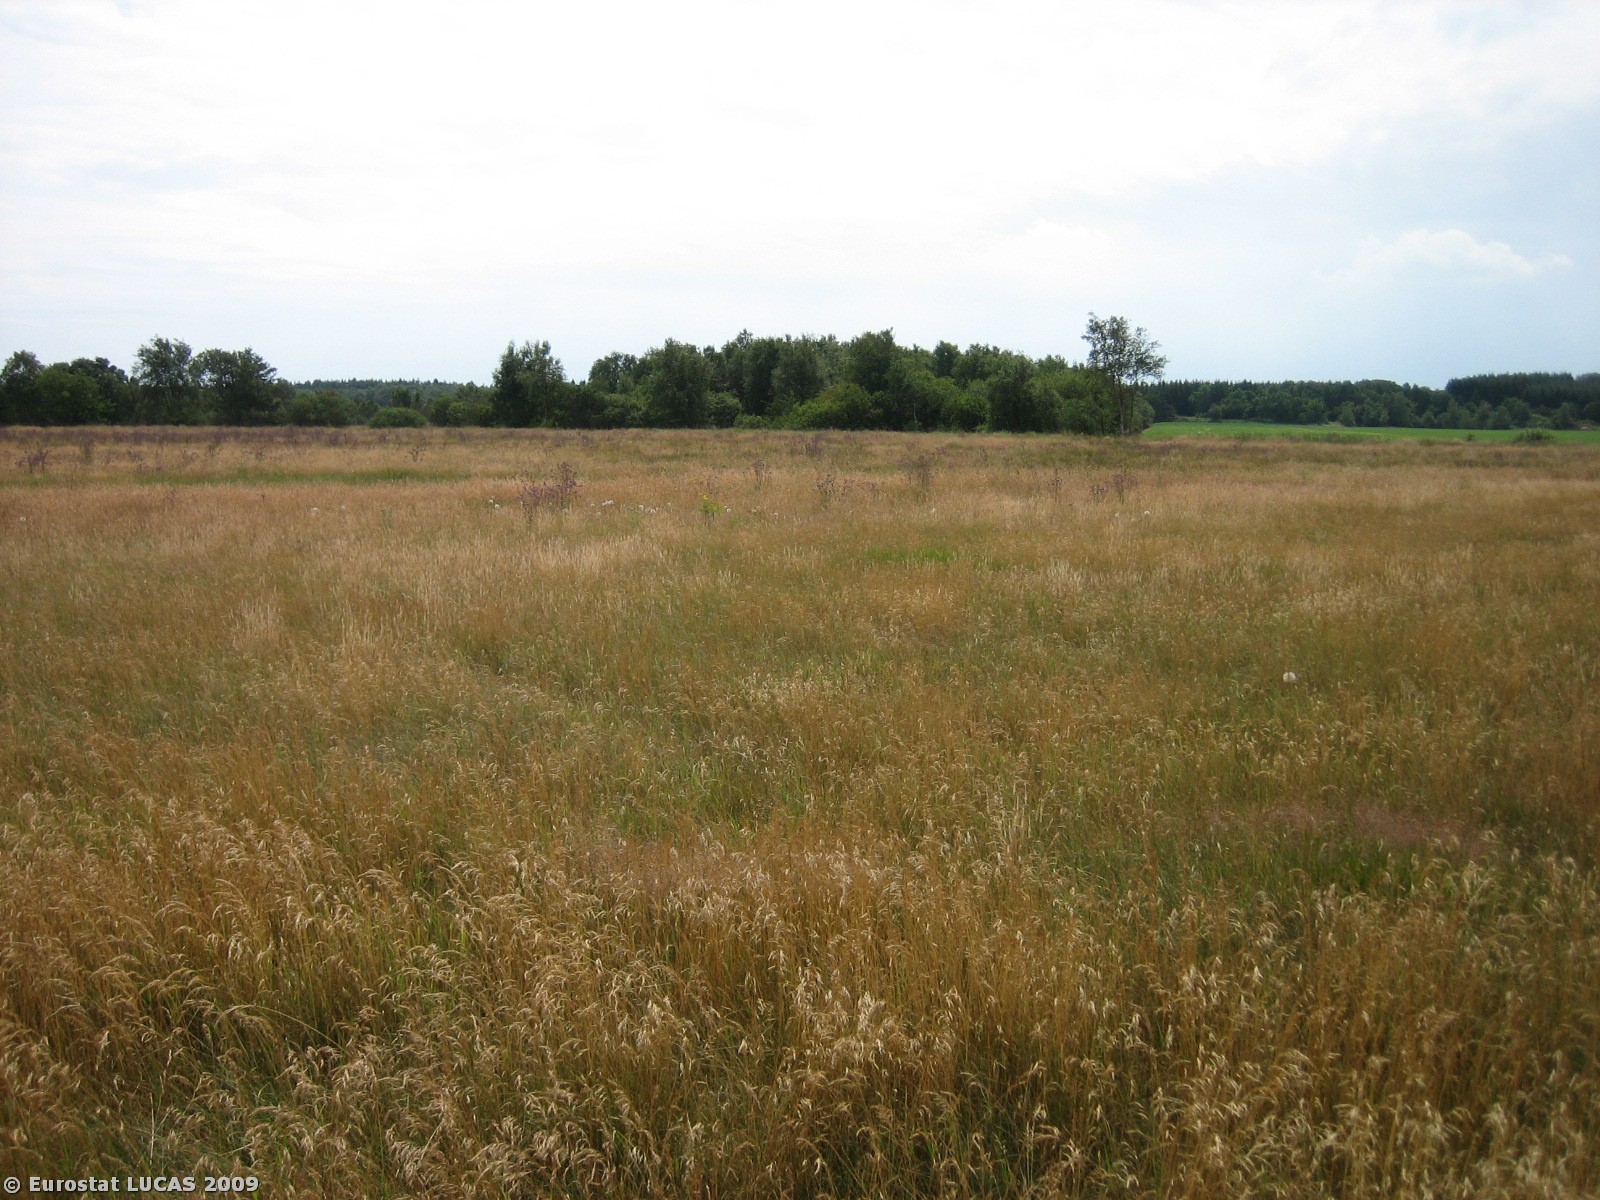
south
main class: Grassland
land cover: Grassland without tree/shrub cover
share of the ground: > 75 %
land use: Fallow land
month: July
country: DK
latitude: 55.8945
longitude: 8.8019
